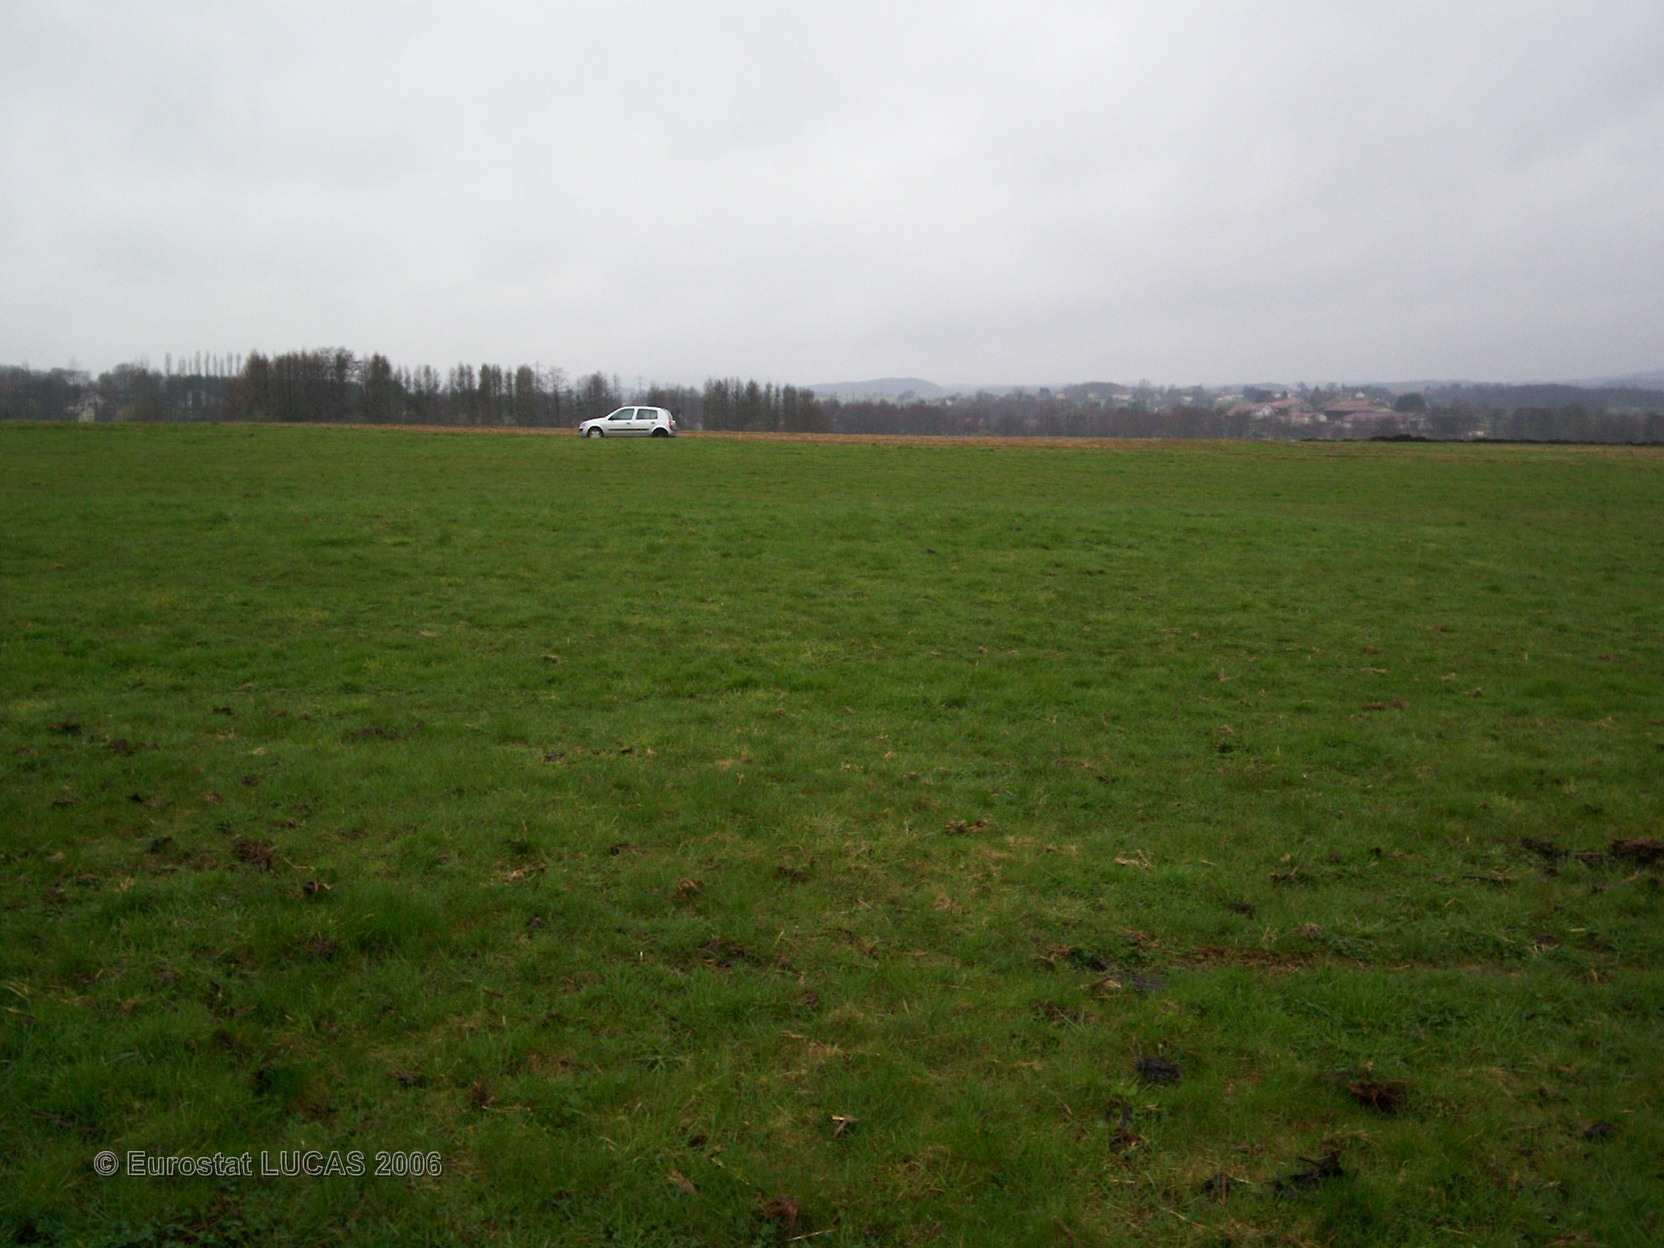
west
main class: Grassland
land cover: Grassland without tree/shrub cover
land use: Agriculture (excluding fallow land and kitchen gardens)
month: April
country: FR
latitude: 47.6734
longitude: 6.8183
